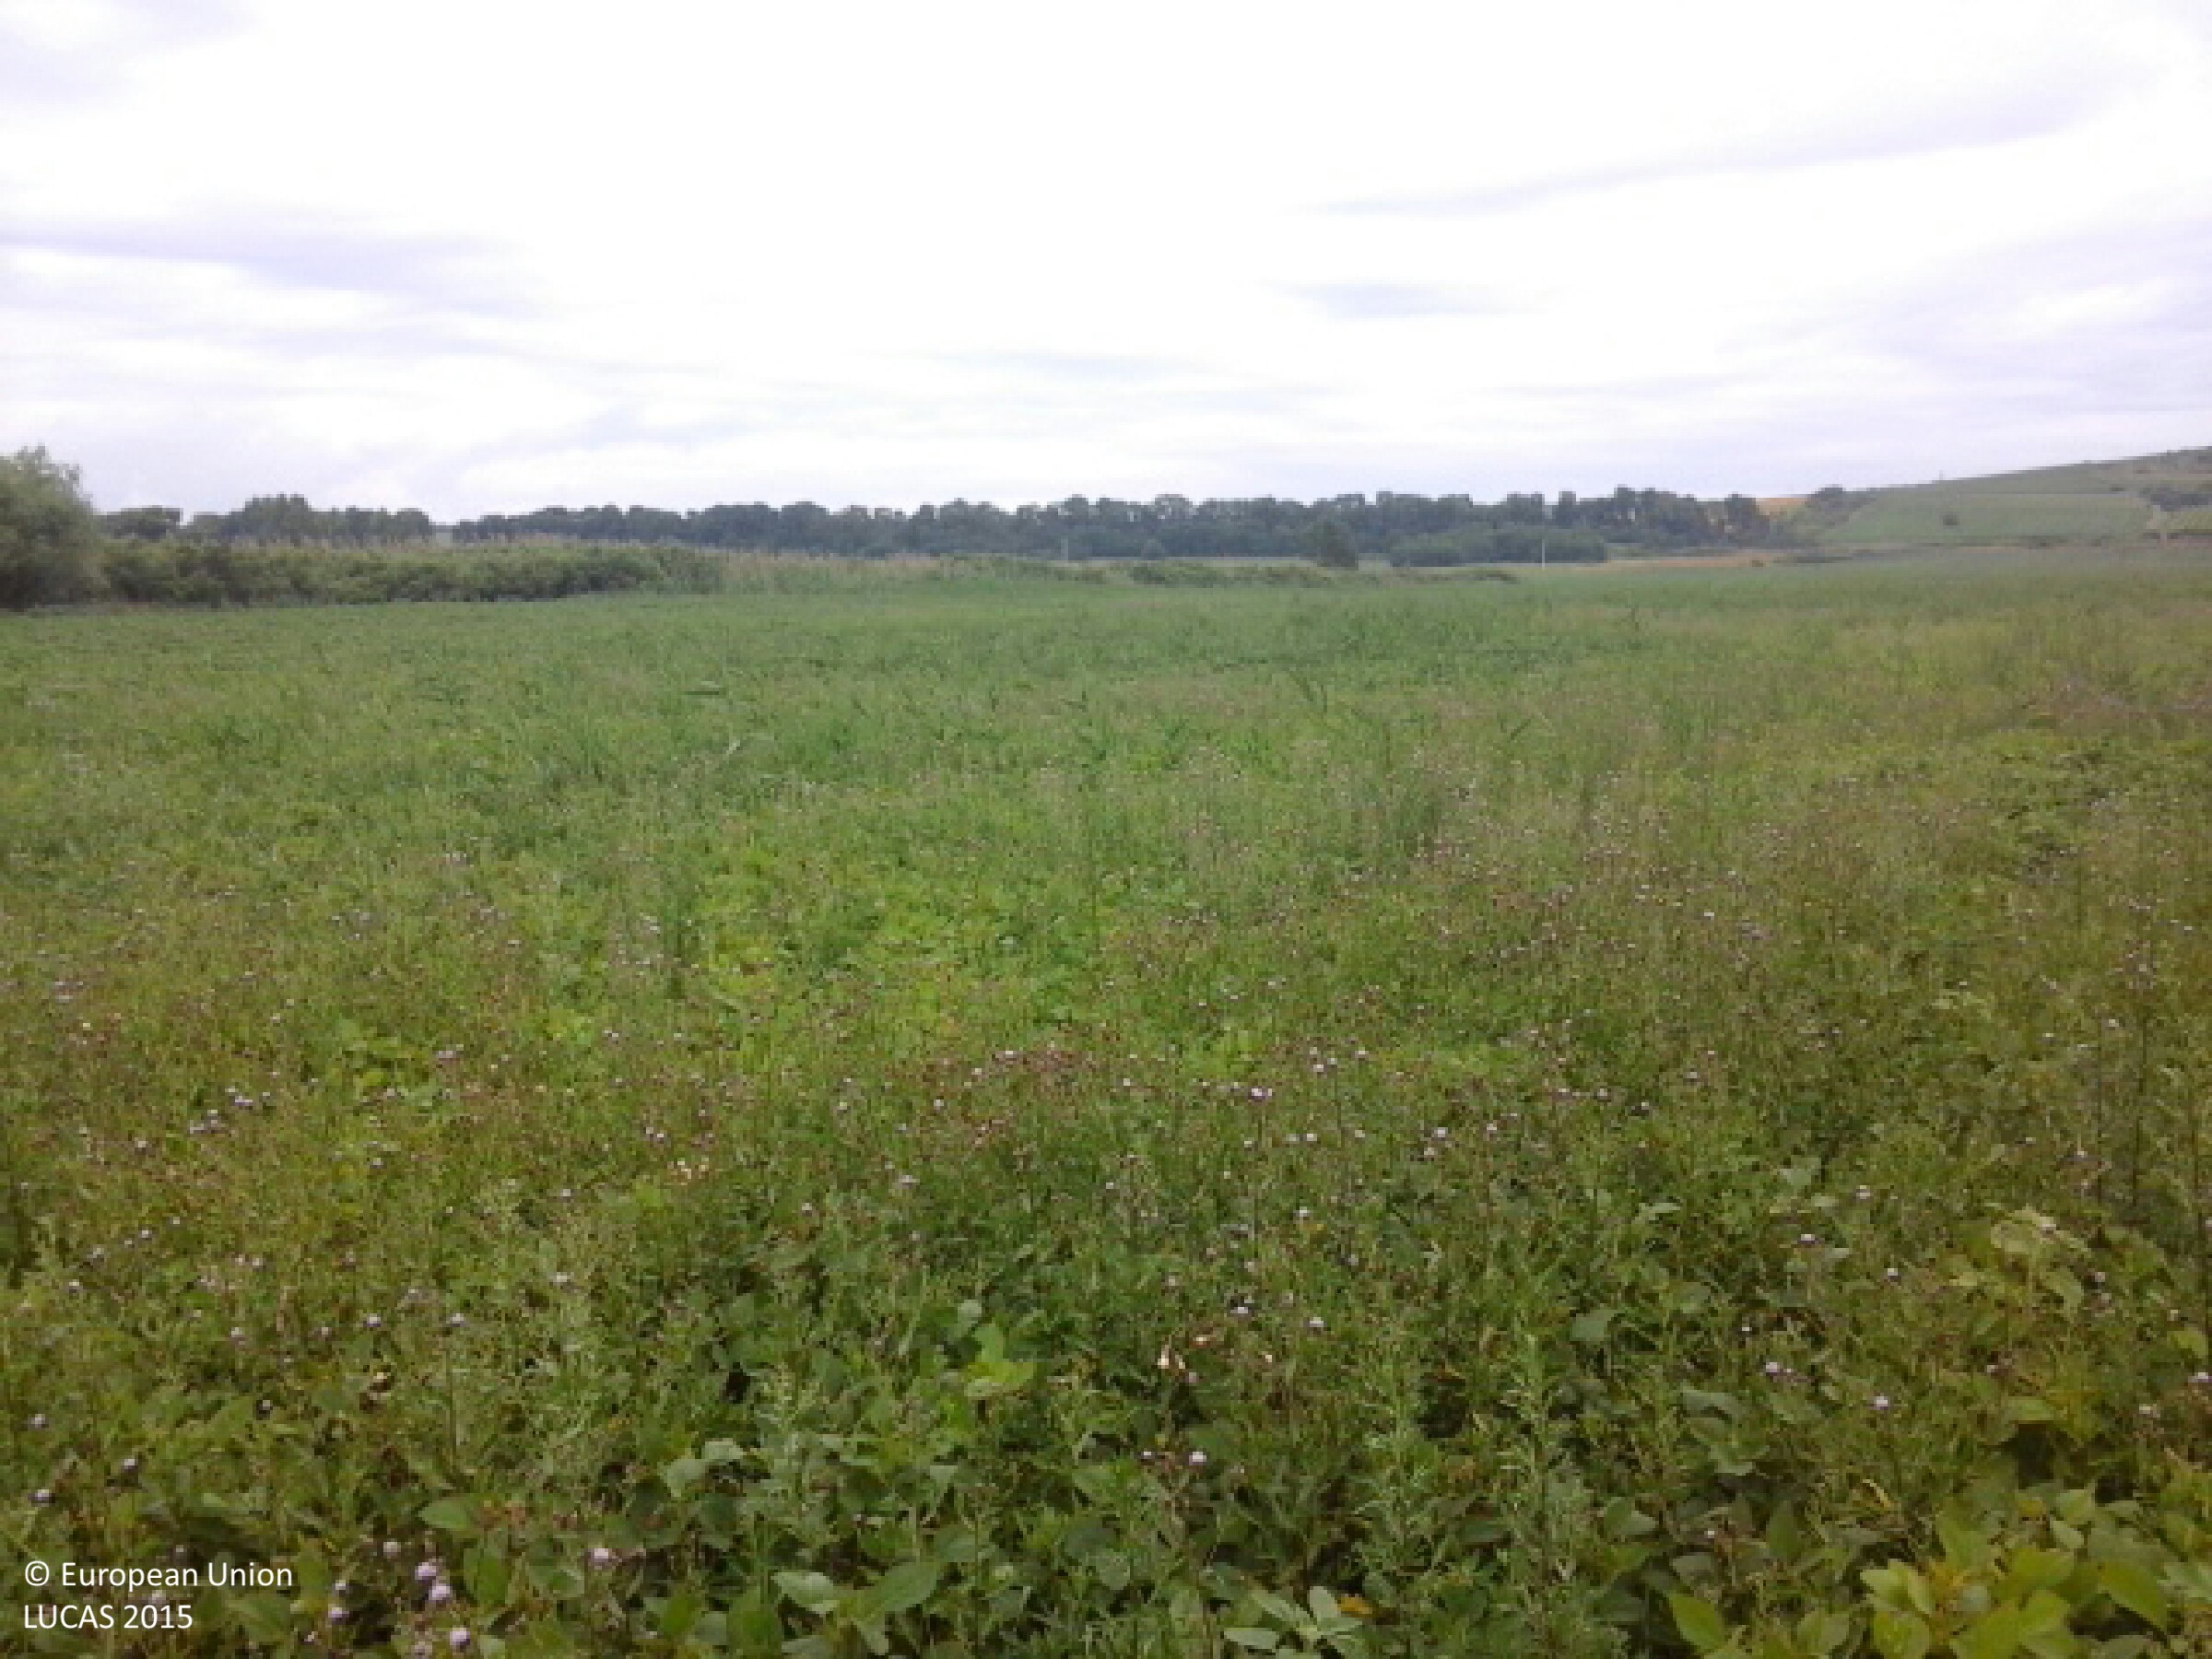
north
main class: Grassland
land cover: Spontaneously vegetated surfaces
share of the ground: > 75 %
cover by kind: herbaceous plants 100 %
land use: Abandoned areas
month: July
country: HU
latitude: 48.2550
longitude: 21.1536
